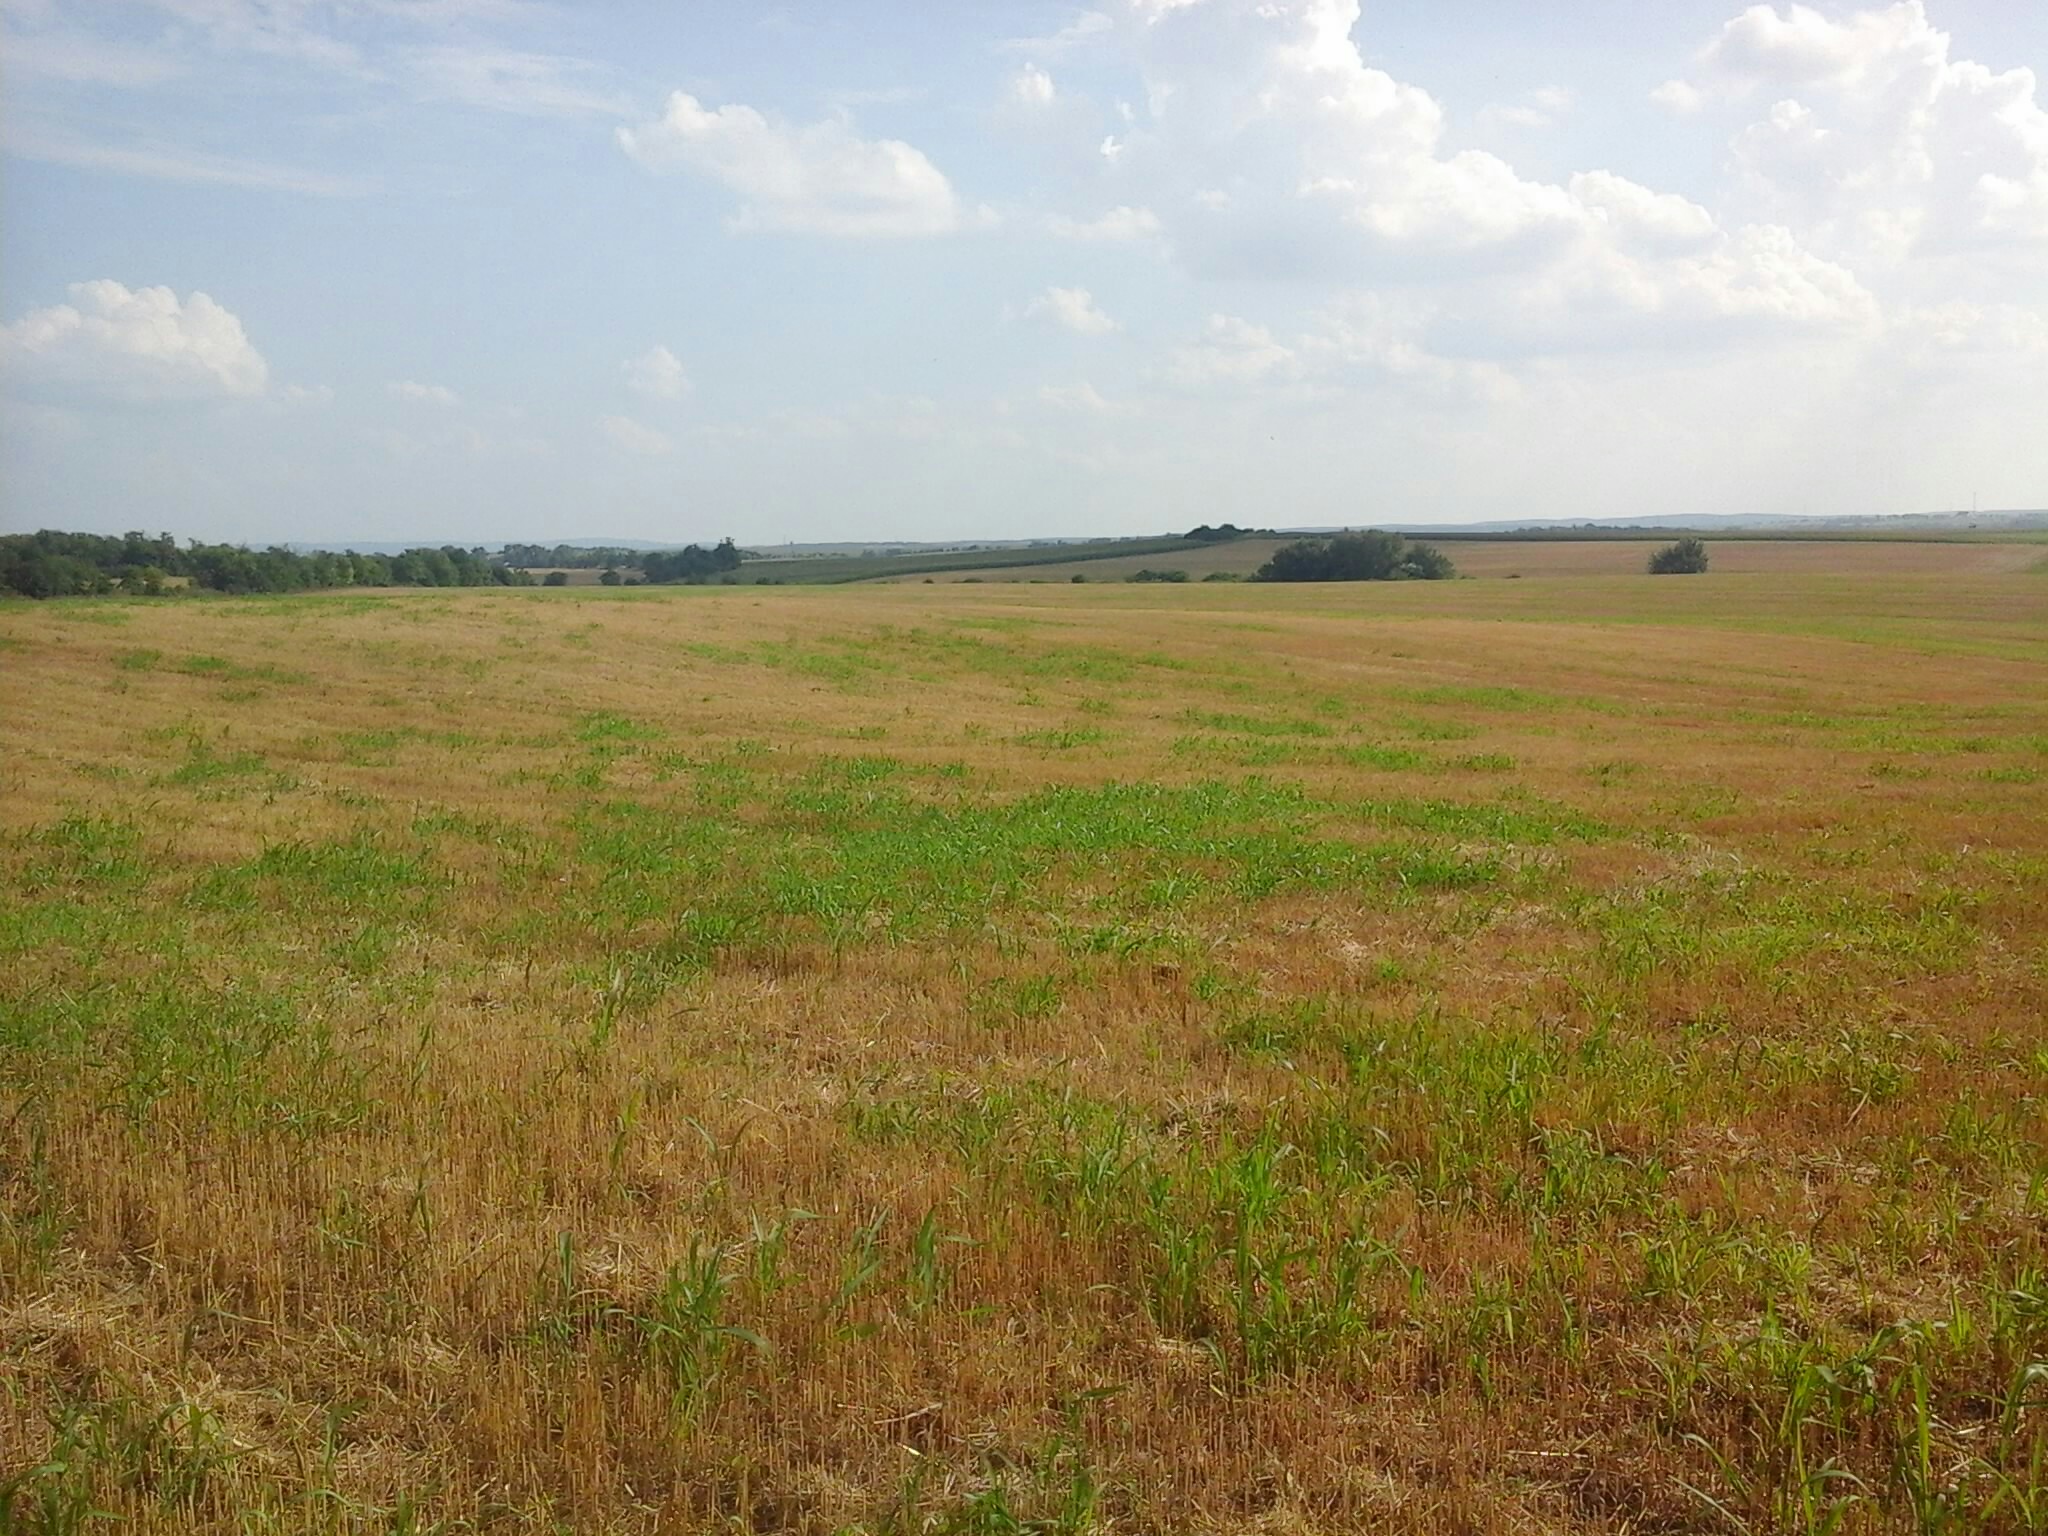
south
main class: Cropland
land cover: Common wheat
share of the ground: > 75 %
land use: Agriculture (excluding fallow land and kitchen gardens)
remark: Harvested field
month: August
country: HU
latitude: 47.5730
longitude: 18.2144
